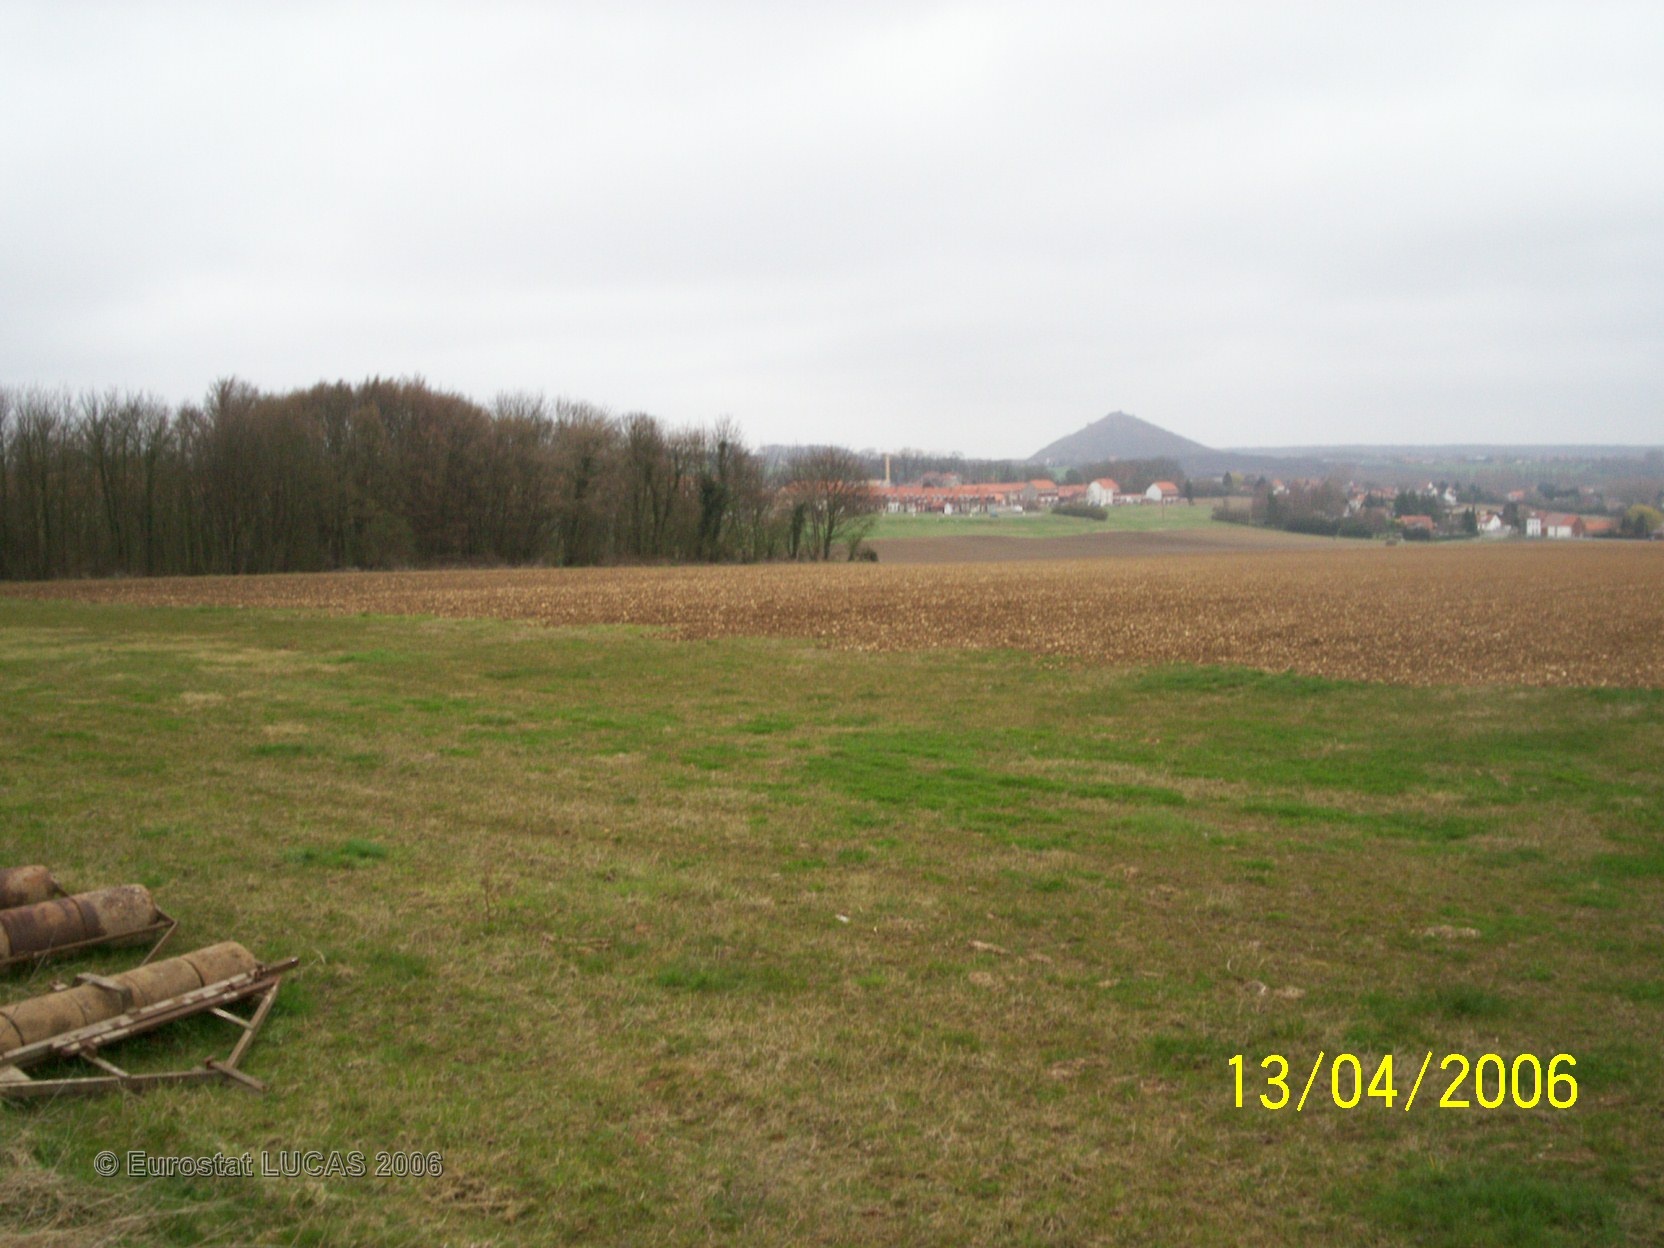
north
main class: Grassland
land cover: Grassland without tree/shrub cover
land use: Agriculture (excluding fallow land and kitchen gardens)
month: April
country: FR
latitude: 50.4613
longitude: 2.5073
